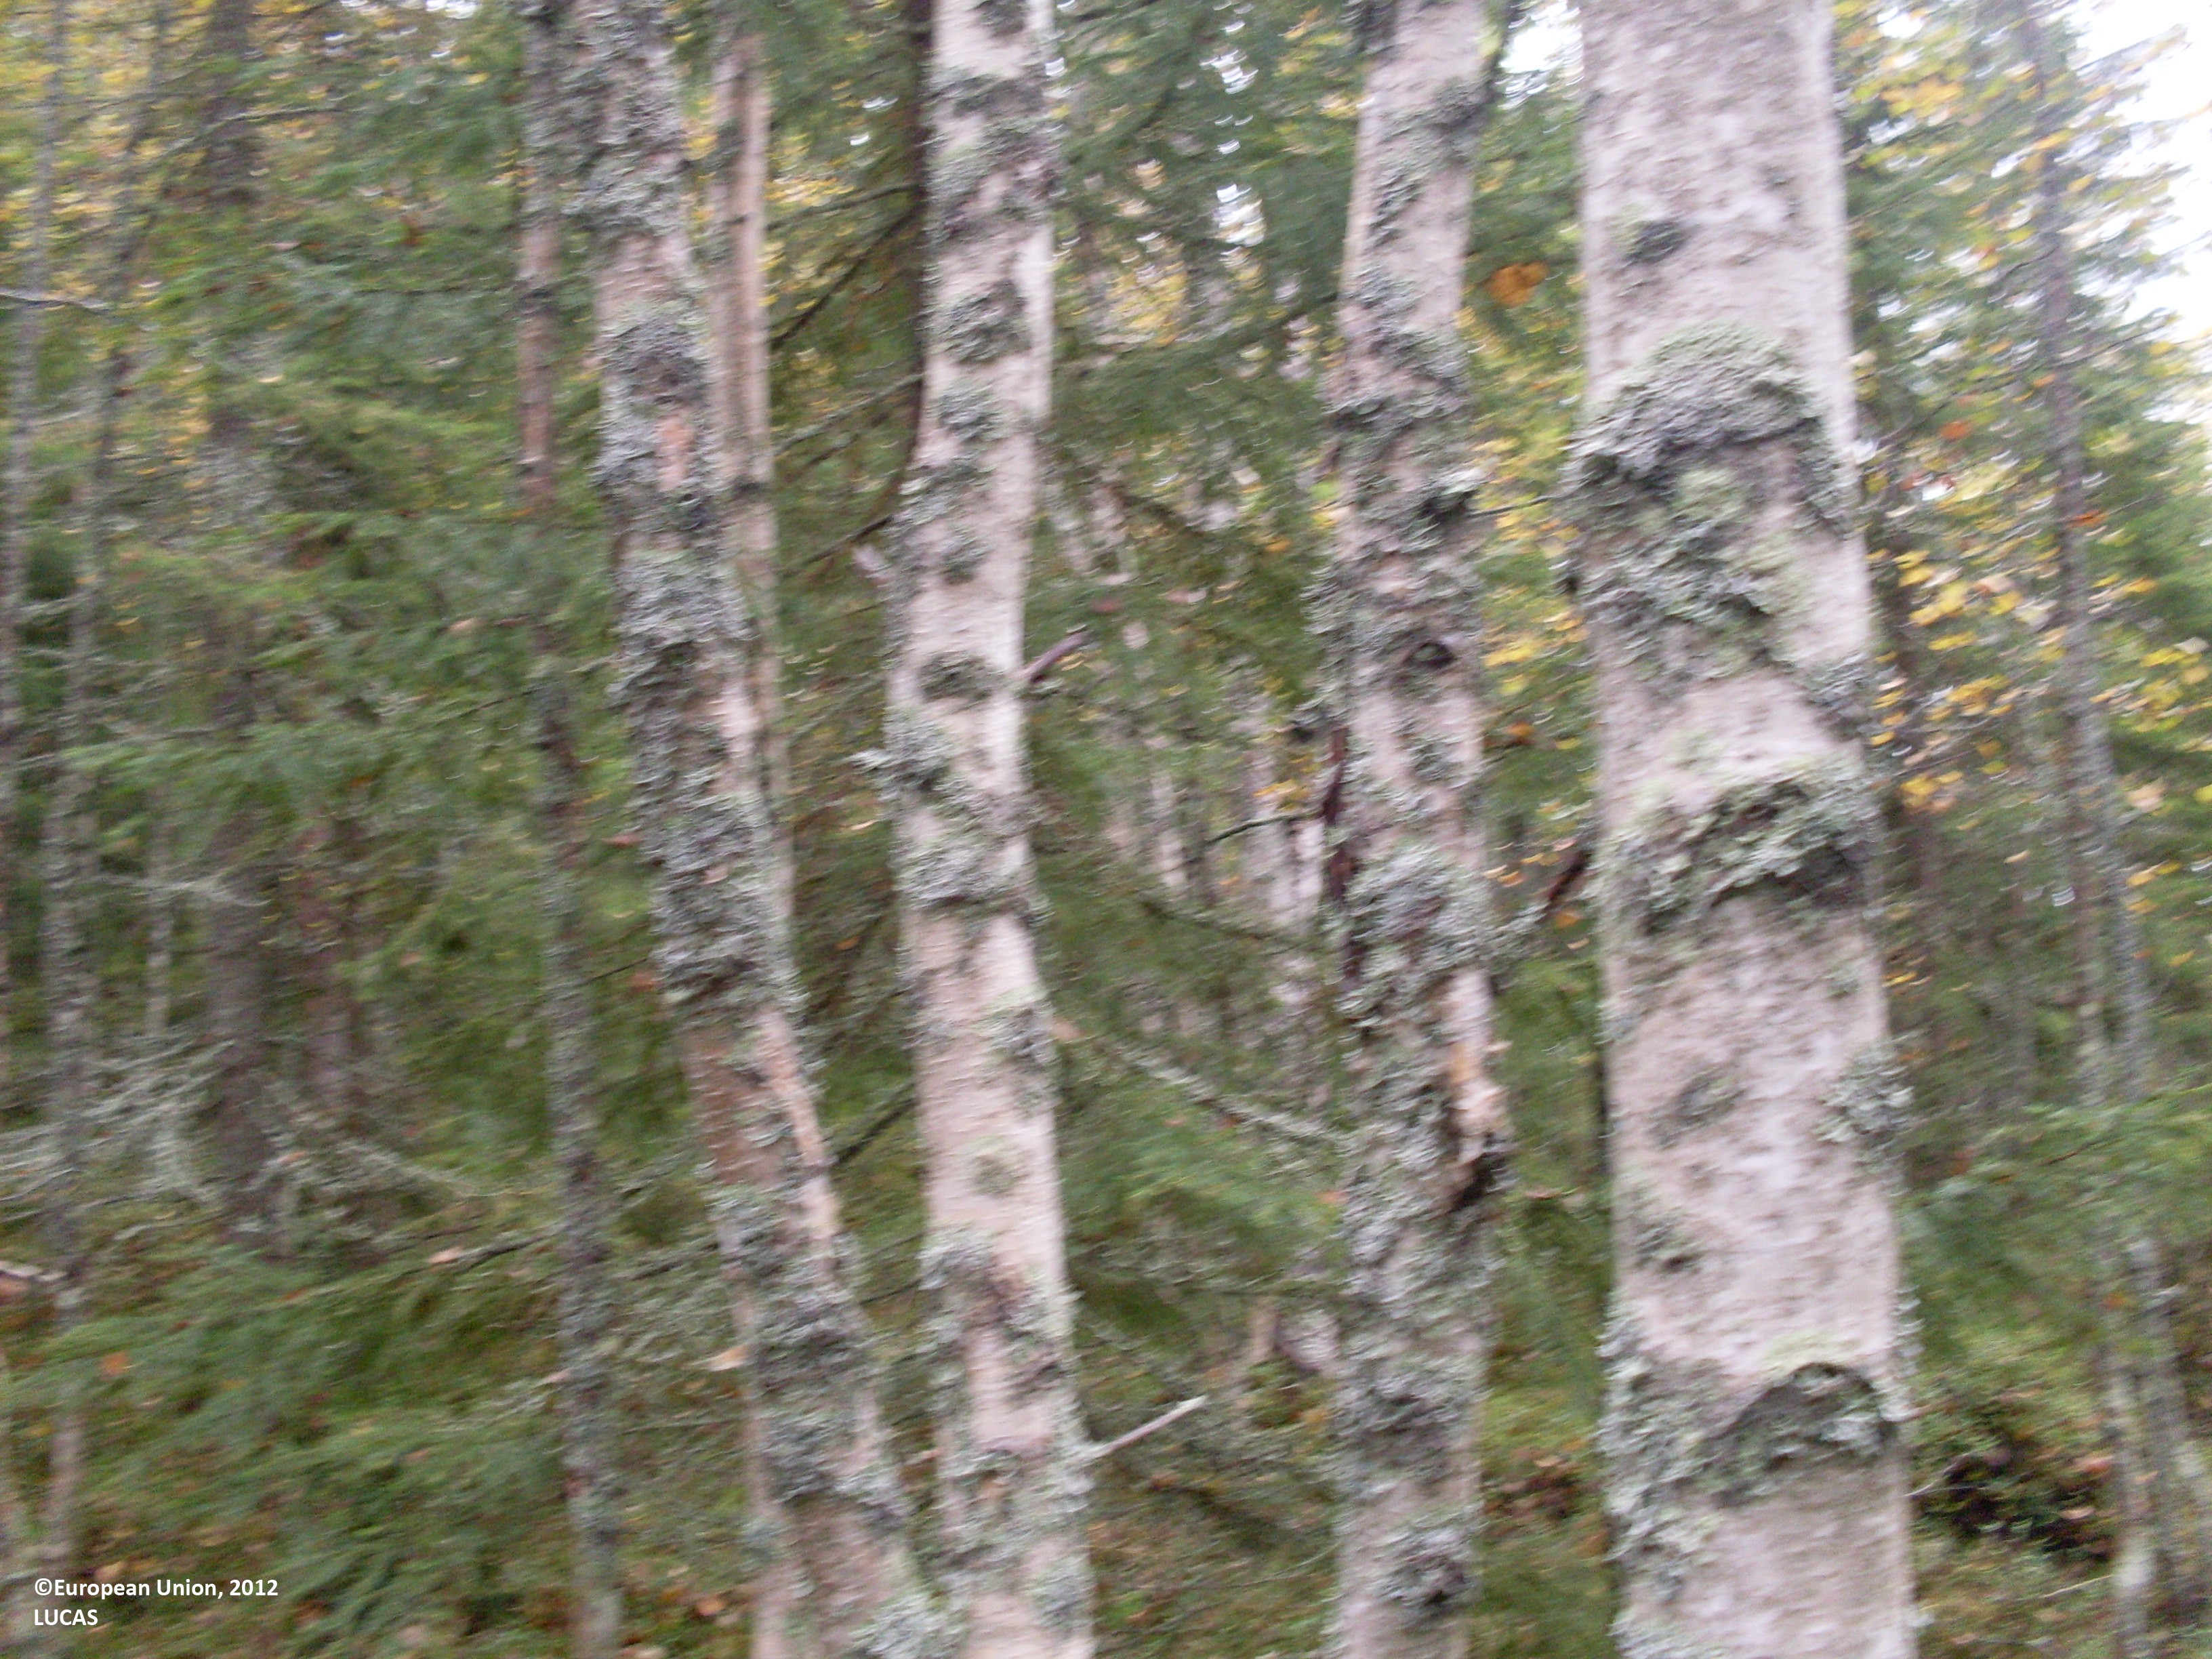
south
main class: Woodland
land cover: Spruce dominated mixed woodland
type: boreal forest
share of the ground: > 75 %
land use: Forestry
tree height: > 5 m
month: September
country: FI
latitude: 64.2140
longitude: 30.2550
